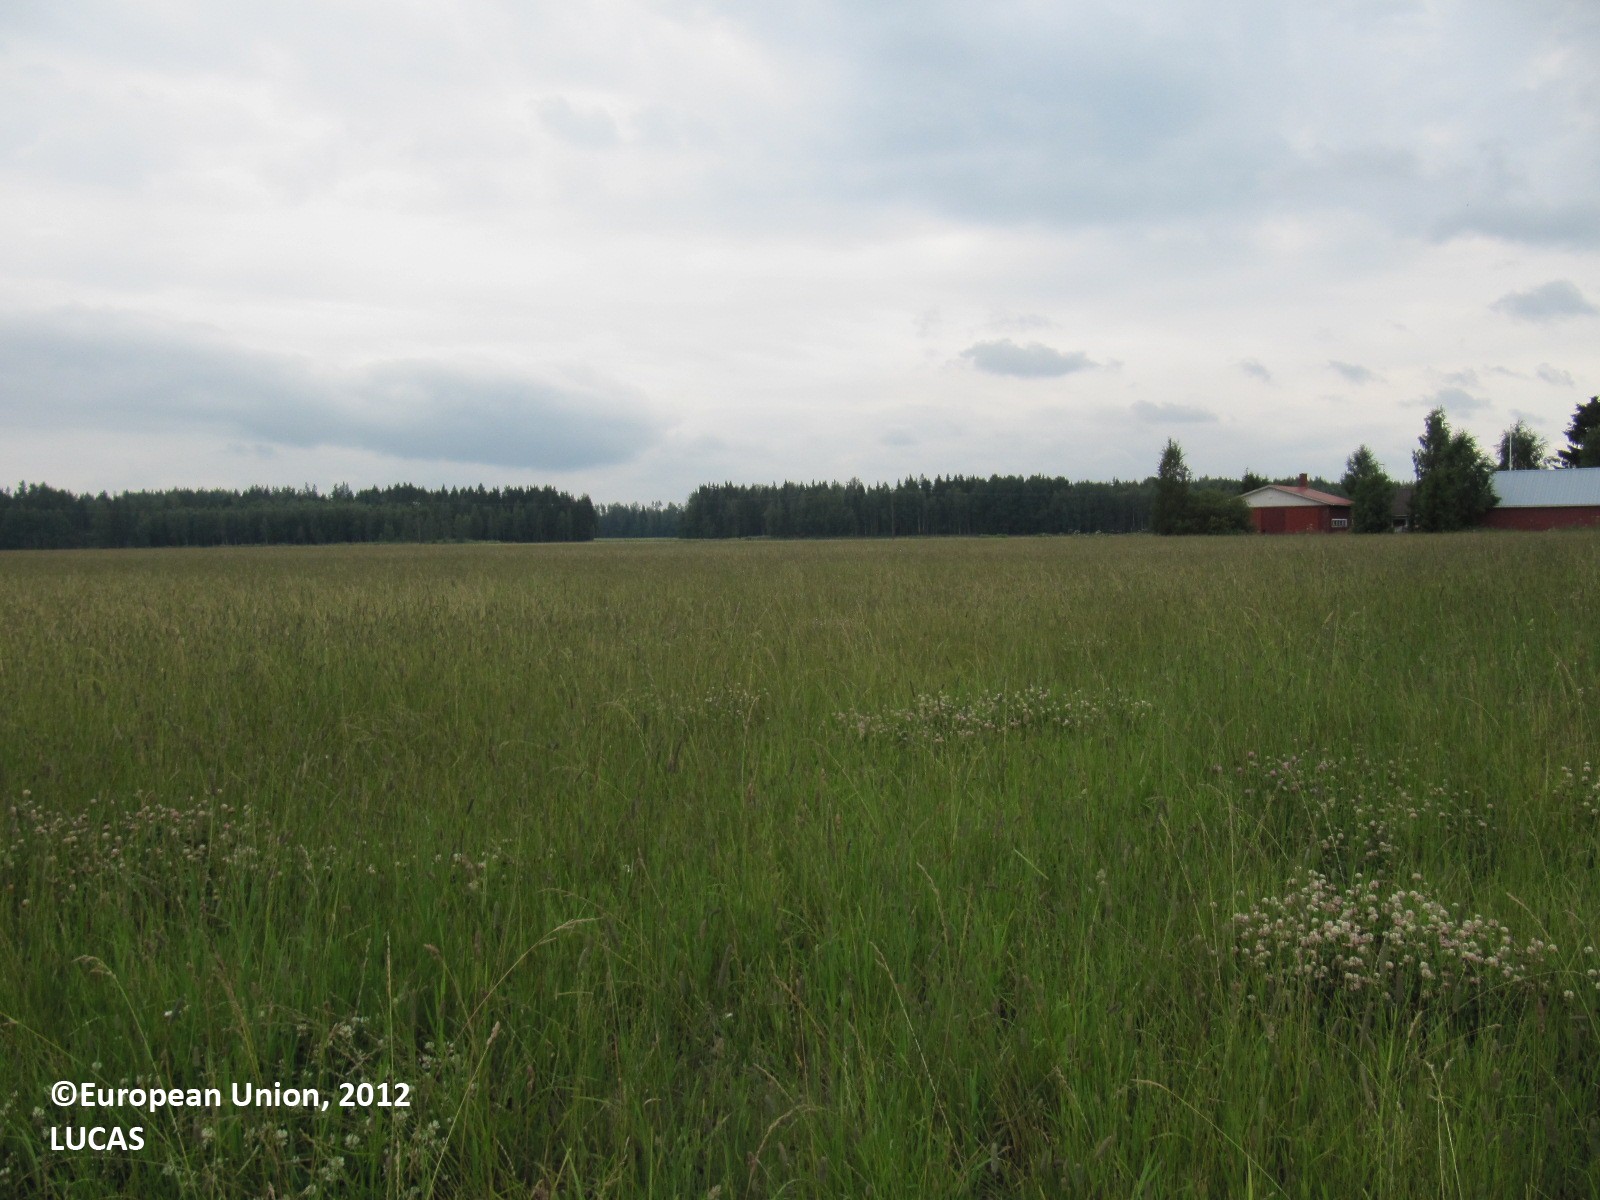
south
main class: Cropland
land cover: Temporary grasslands
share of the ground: > 75 %
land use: Agriculture (excluding fallow land and kitchen gardens)
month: July
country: FI
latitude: 60.7328
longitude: 23.3400
